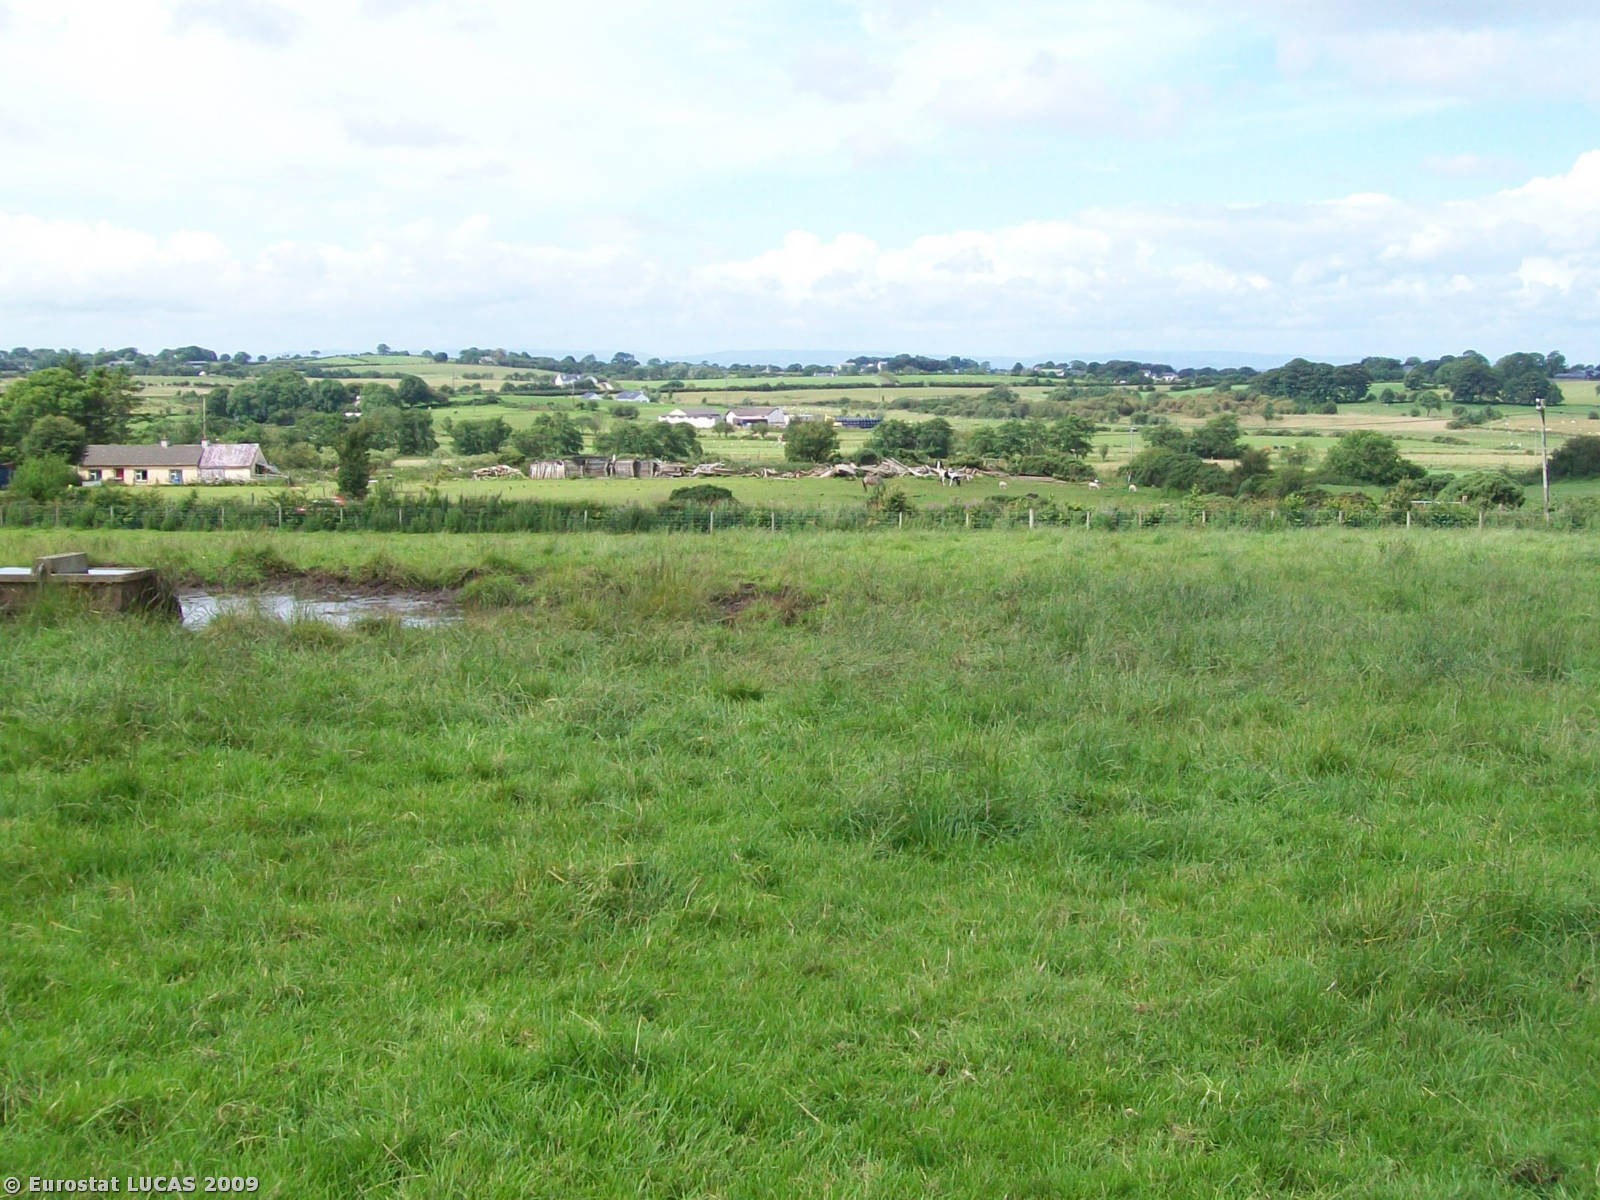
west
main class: Grassland
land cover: Grassland without tree/shrub cover
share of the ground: > 75 %
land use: Agriculture (excluding fallow land and kitchen gardens)
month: July
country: GB
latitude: 55.1148
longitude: -6.3119
